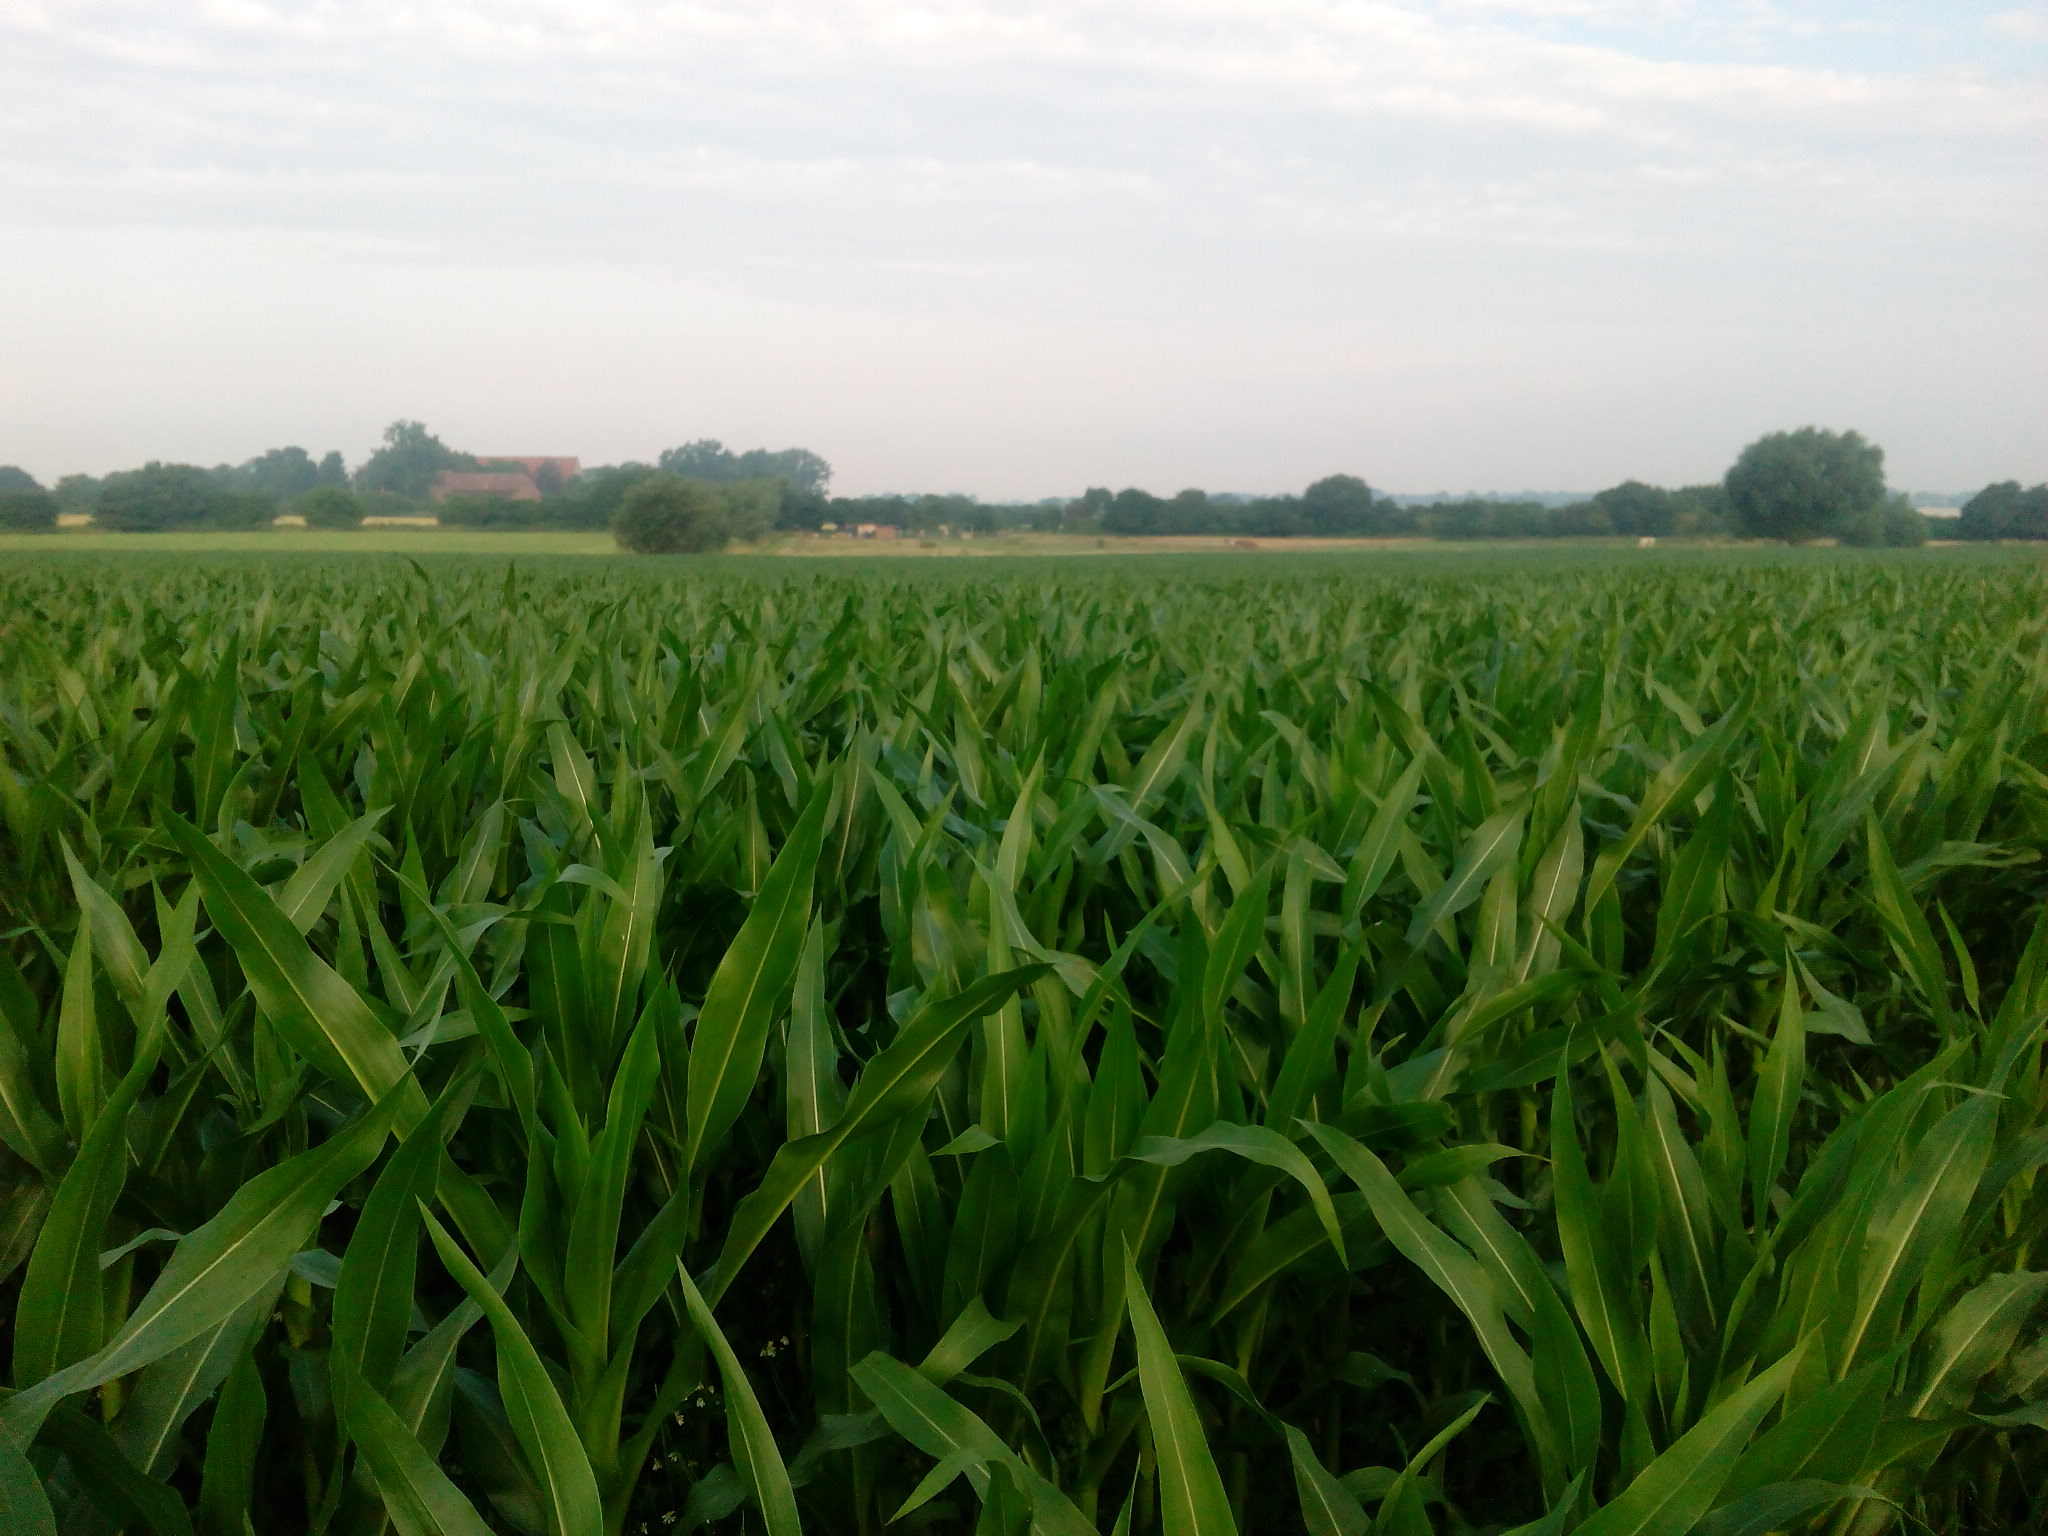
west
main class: Cropland
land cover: Oats
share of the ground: > 75 %
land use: Agriculture (excluding fallow land and kitchen gardens)
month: July
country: DE
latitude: 52.3393
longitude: 9.2811
